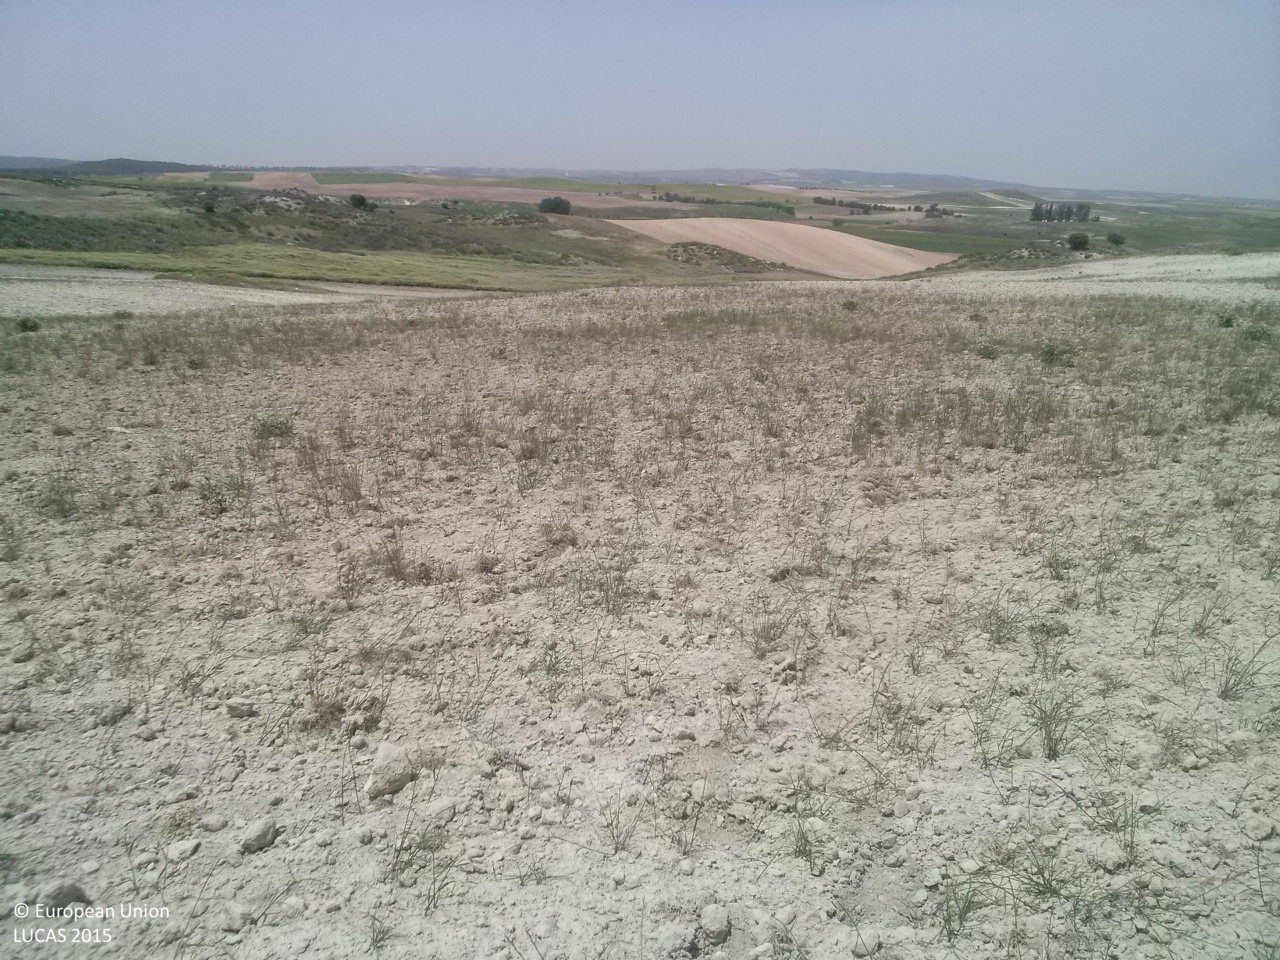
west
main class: Grassland
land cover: Spontaneously vegetated surfaces
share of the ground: < 10 %
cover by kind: unconsolidated bare surface 90 %, herbaceous plants 10 %
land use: Fallow land
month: May
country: ES
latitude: 39.9154
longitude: -2.6891
